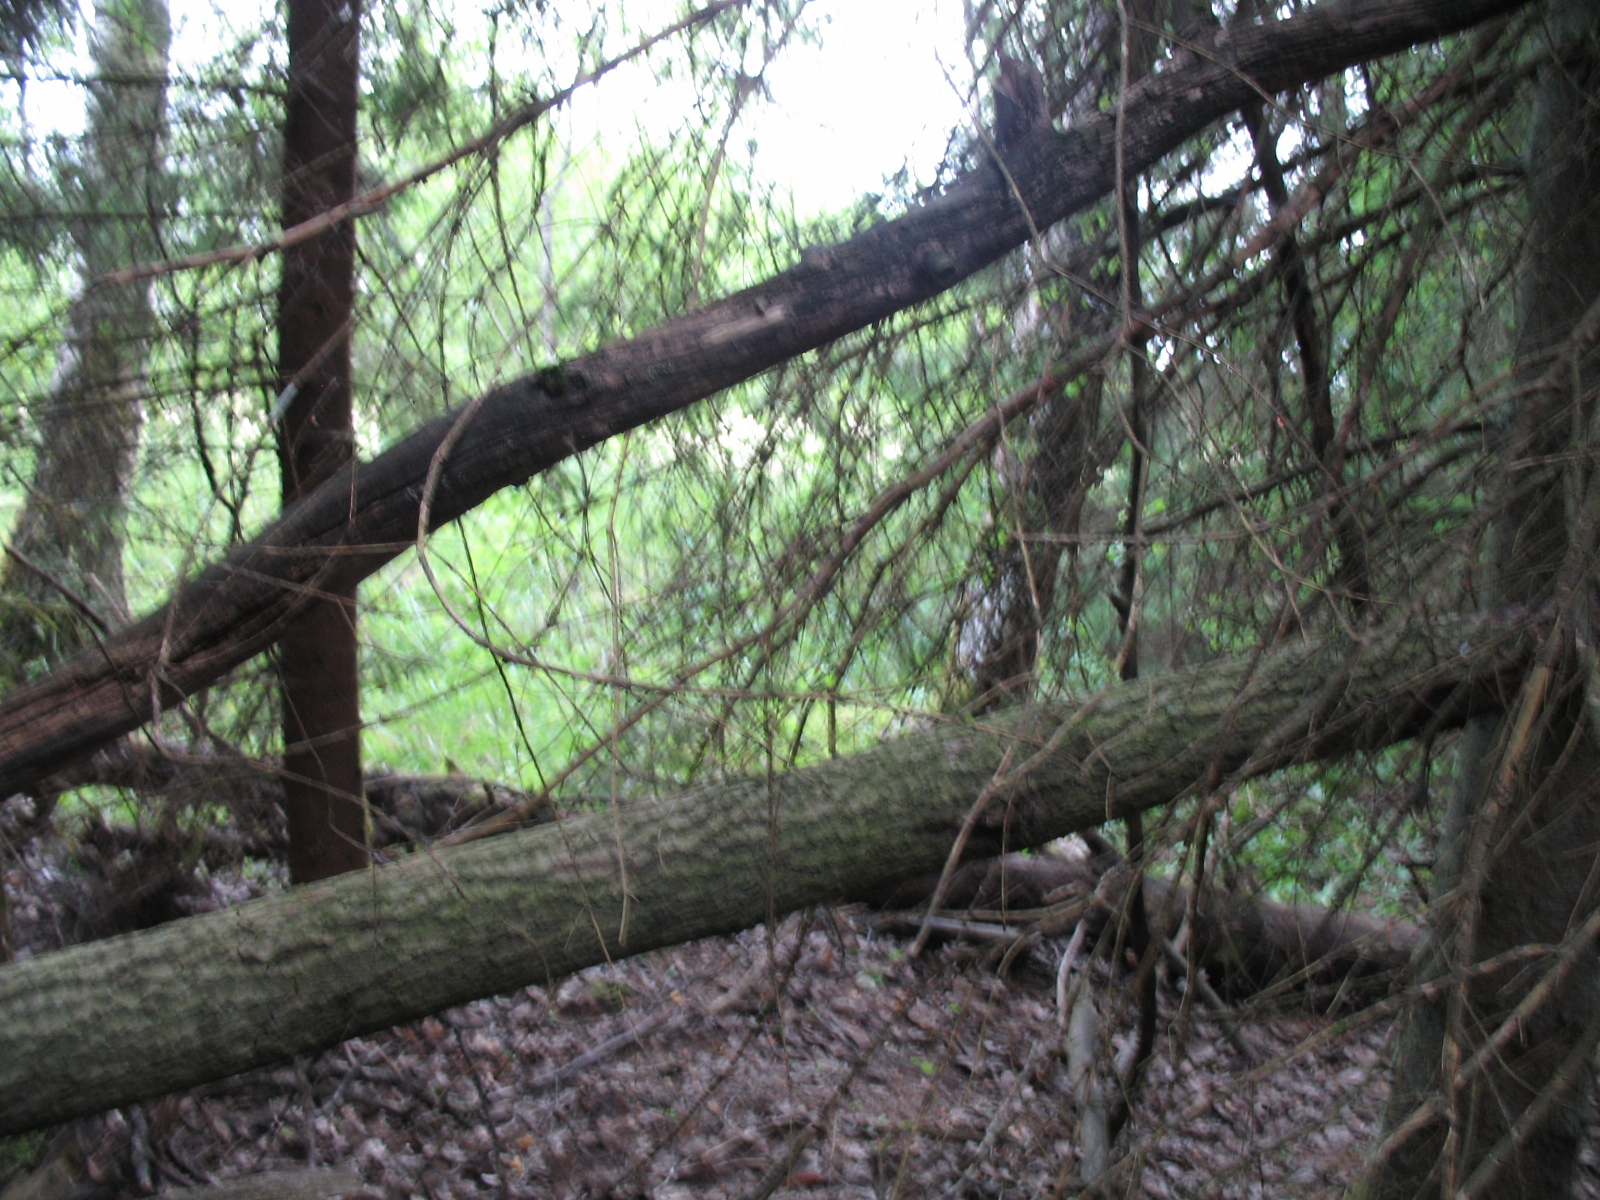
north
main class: Woodland
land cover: Spruce dominated mixed woodland
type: hemiboreal forest and nemoral coniferous forest and mixed broadleaved-coniferous forest
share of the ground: > 75 %
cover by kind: coniferous forest trees 50 %, broadleaved forest trees 45 %, herbaceous plants 5 %
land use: Forestry
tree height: > 5 m
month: June
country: LV
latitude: 56.7637
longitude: 23.8720
